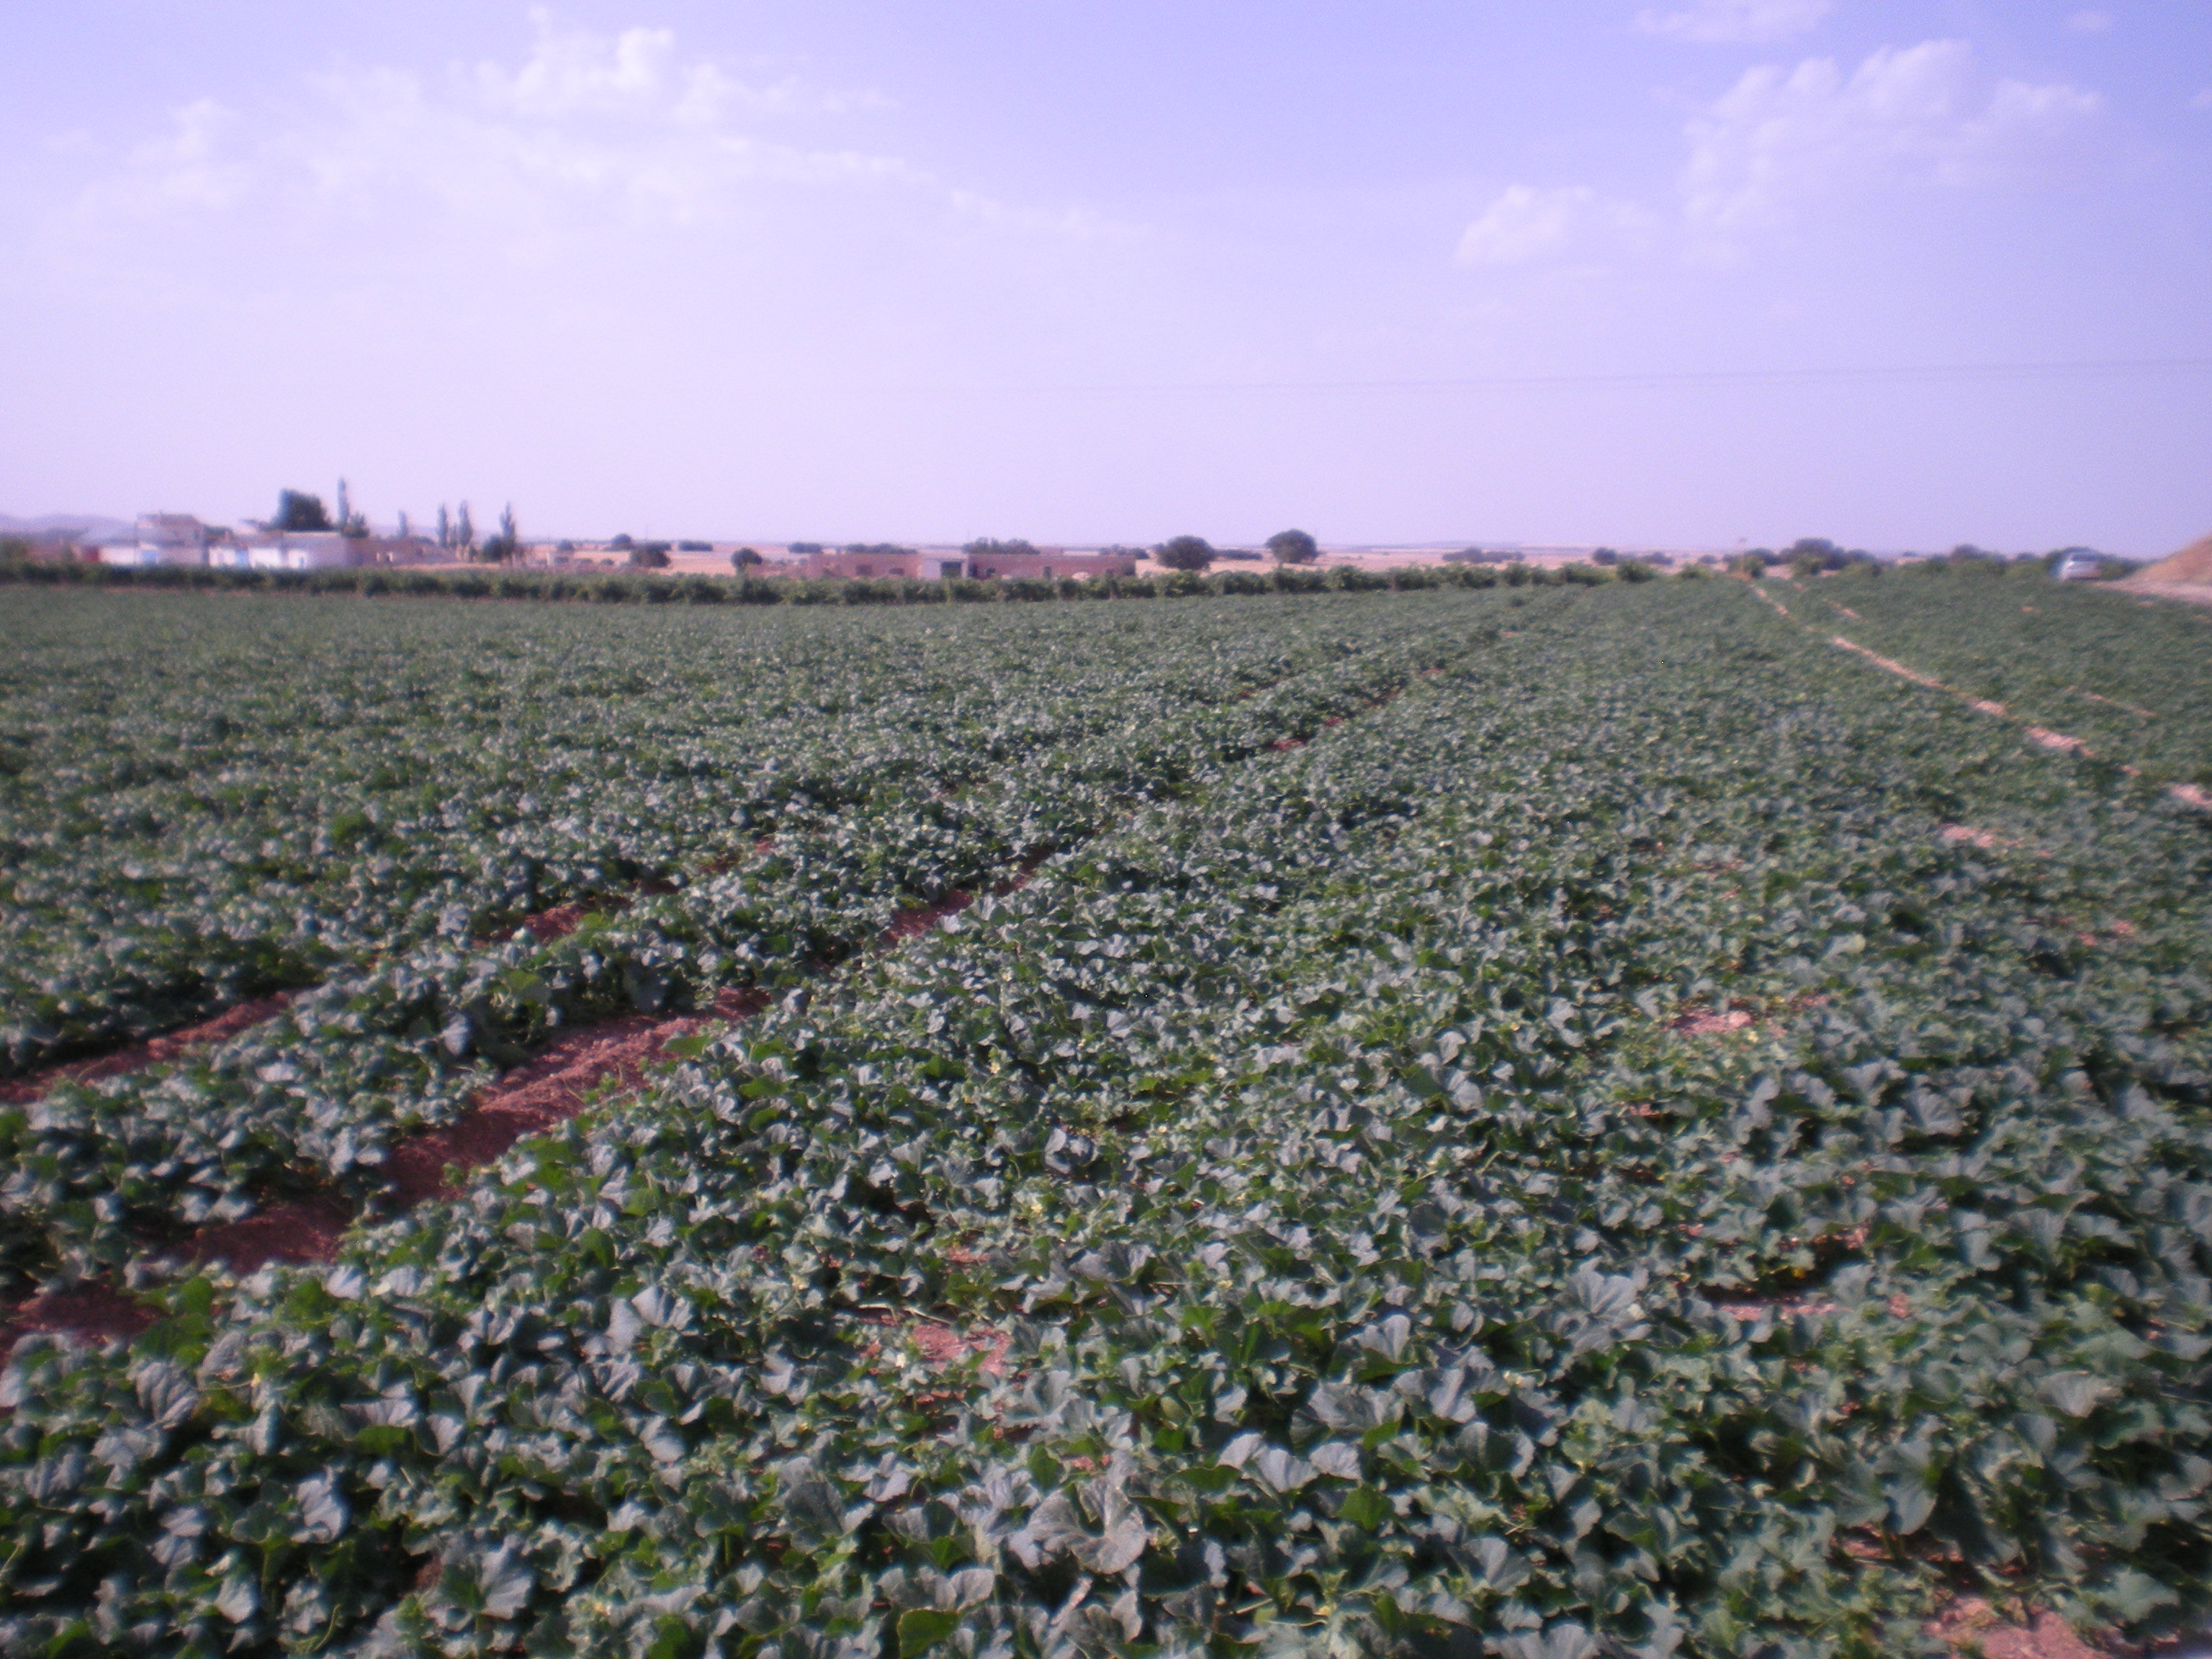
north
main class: Cropland
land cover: Other fresh vegetables
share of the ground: > 75 %
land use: Agriculture (excluding fallow land and kitchen gardens)
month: July
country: ES
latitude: 39.2675
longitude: -3.2881
